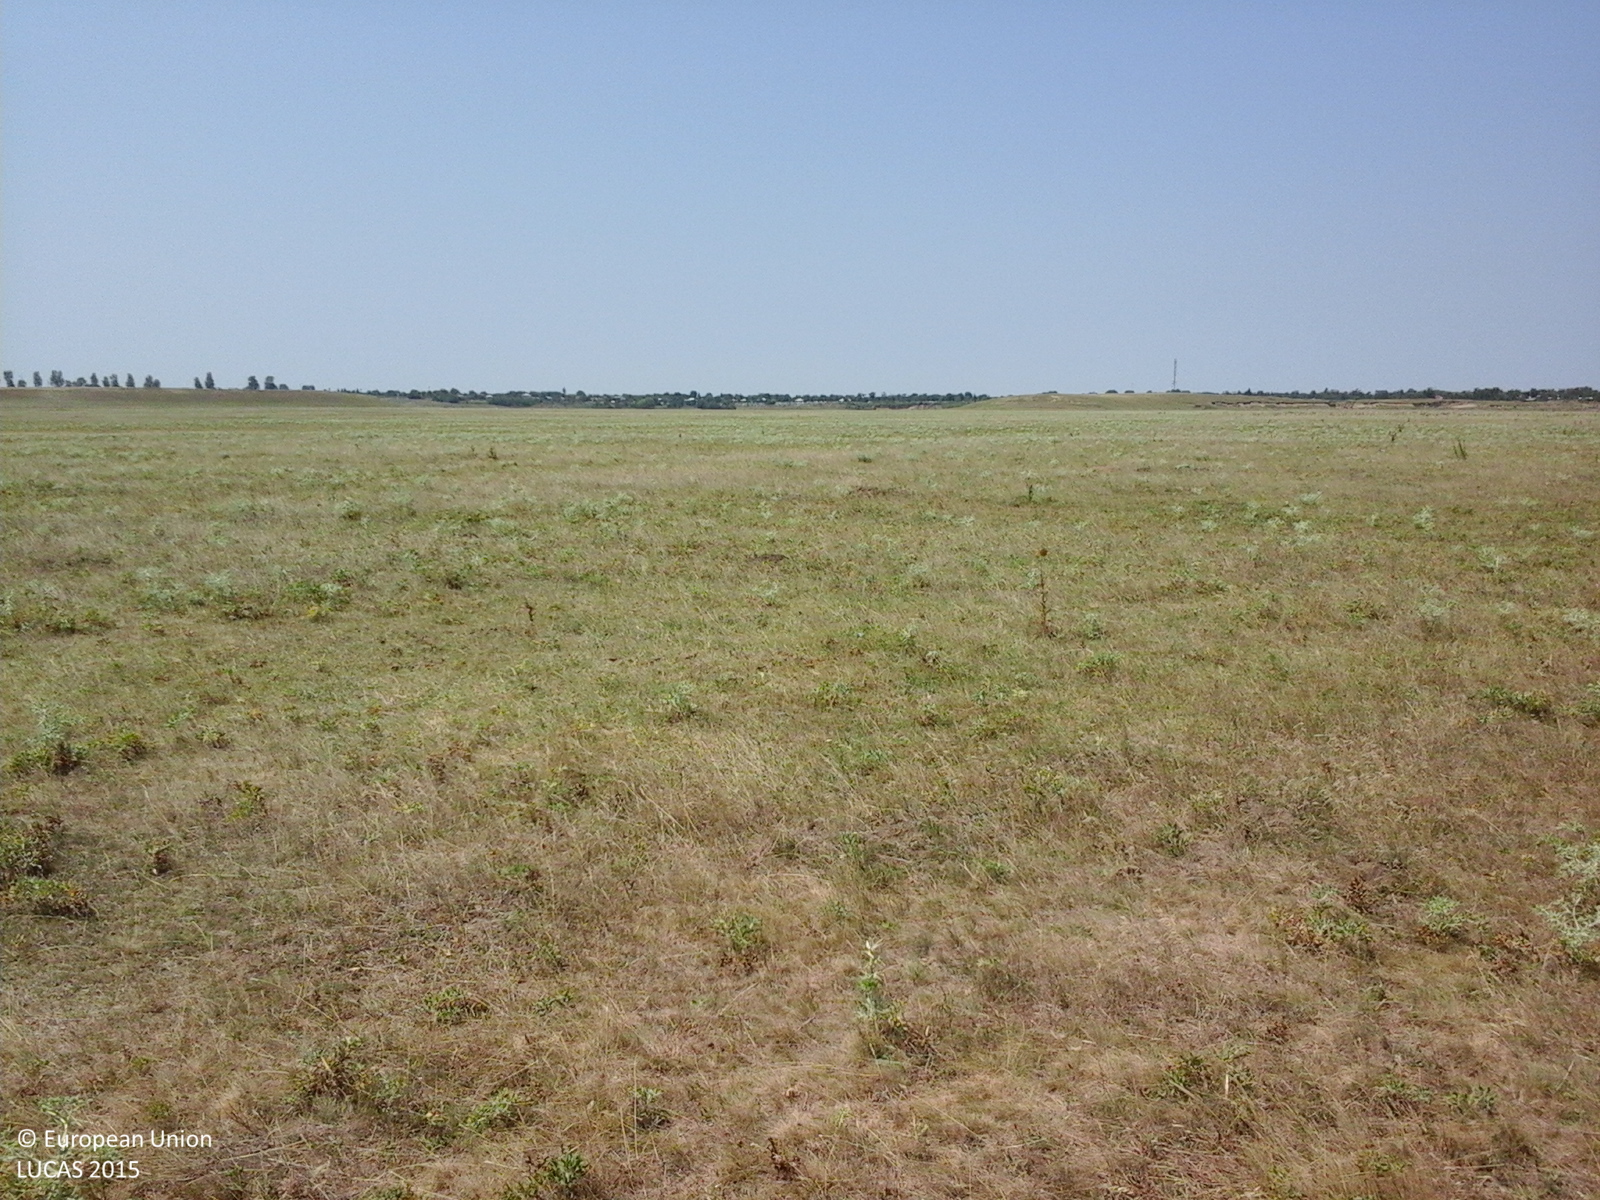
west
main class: Grassland
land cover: Grassland without tree/shrub cover
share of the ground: > 75 %
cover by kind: herbaceous plants 100 %
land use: Agriculture (excluding fallow land and kitchen gardens)
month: July
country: RO
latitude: 44.9560
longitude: 27.2406
